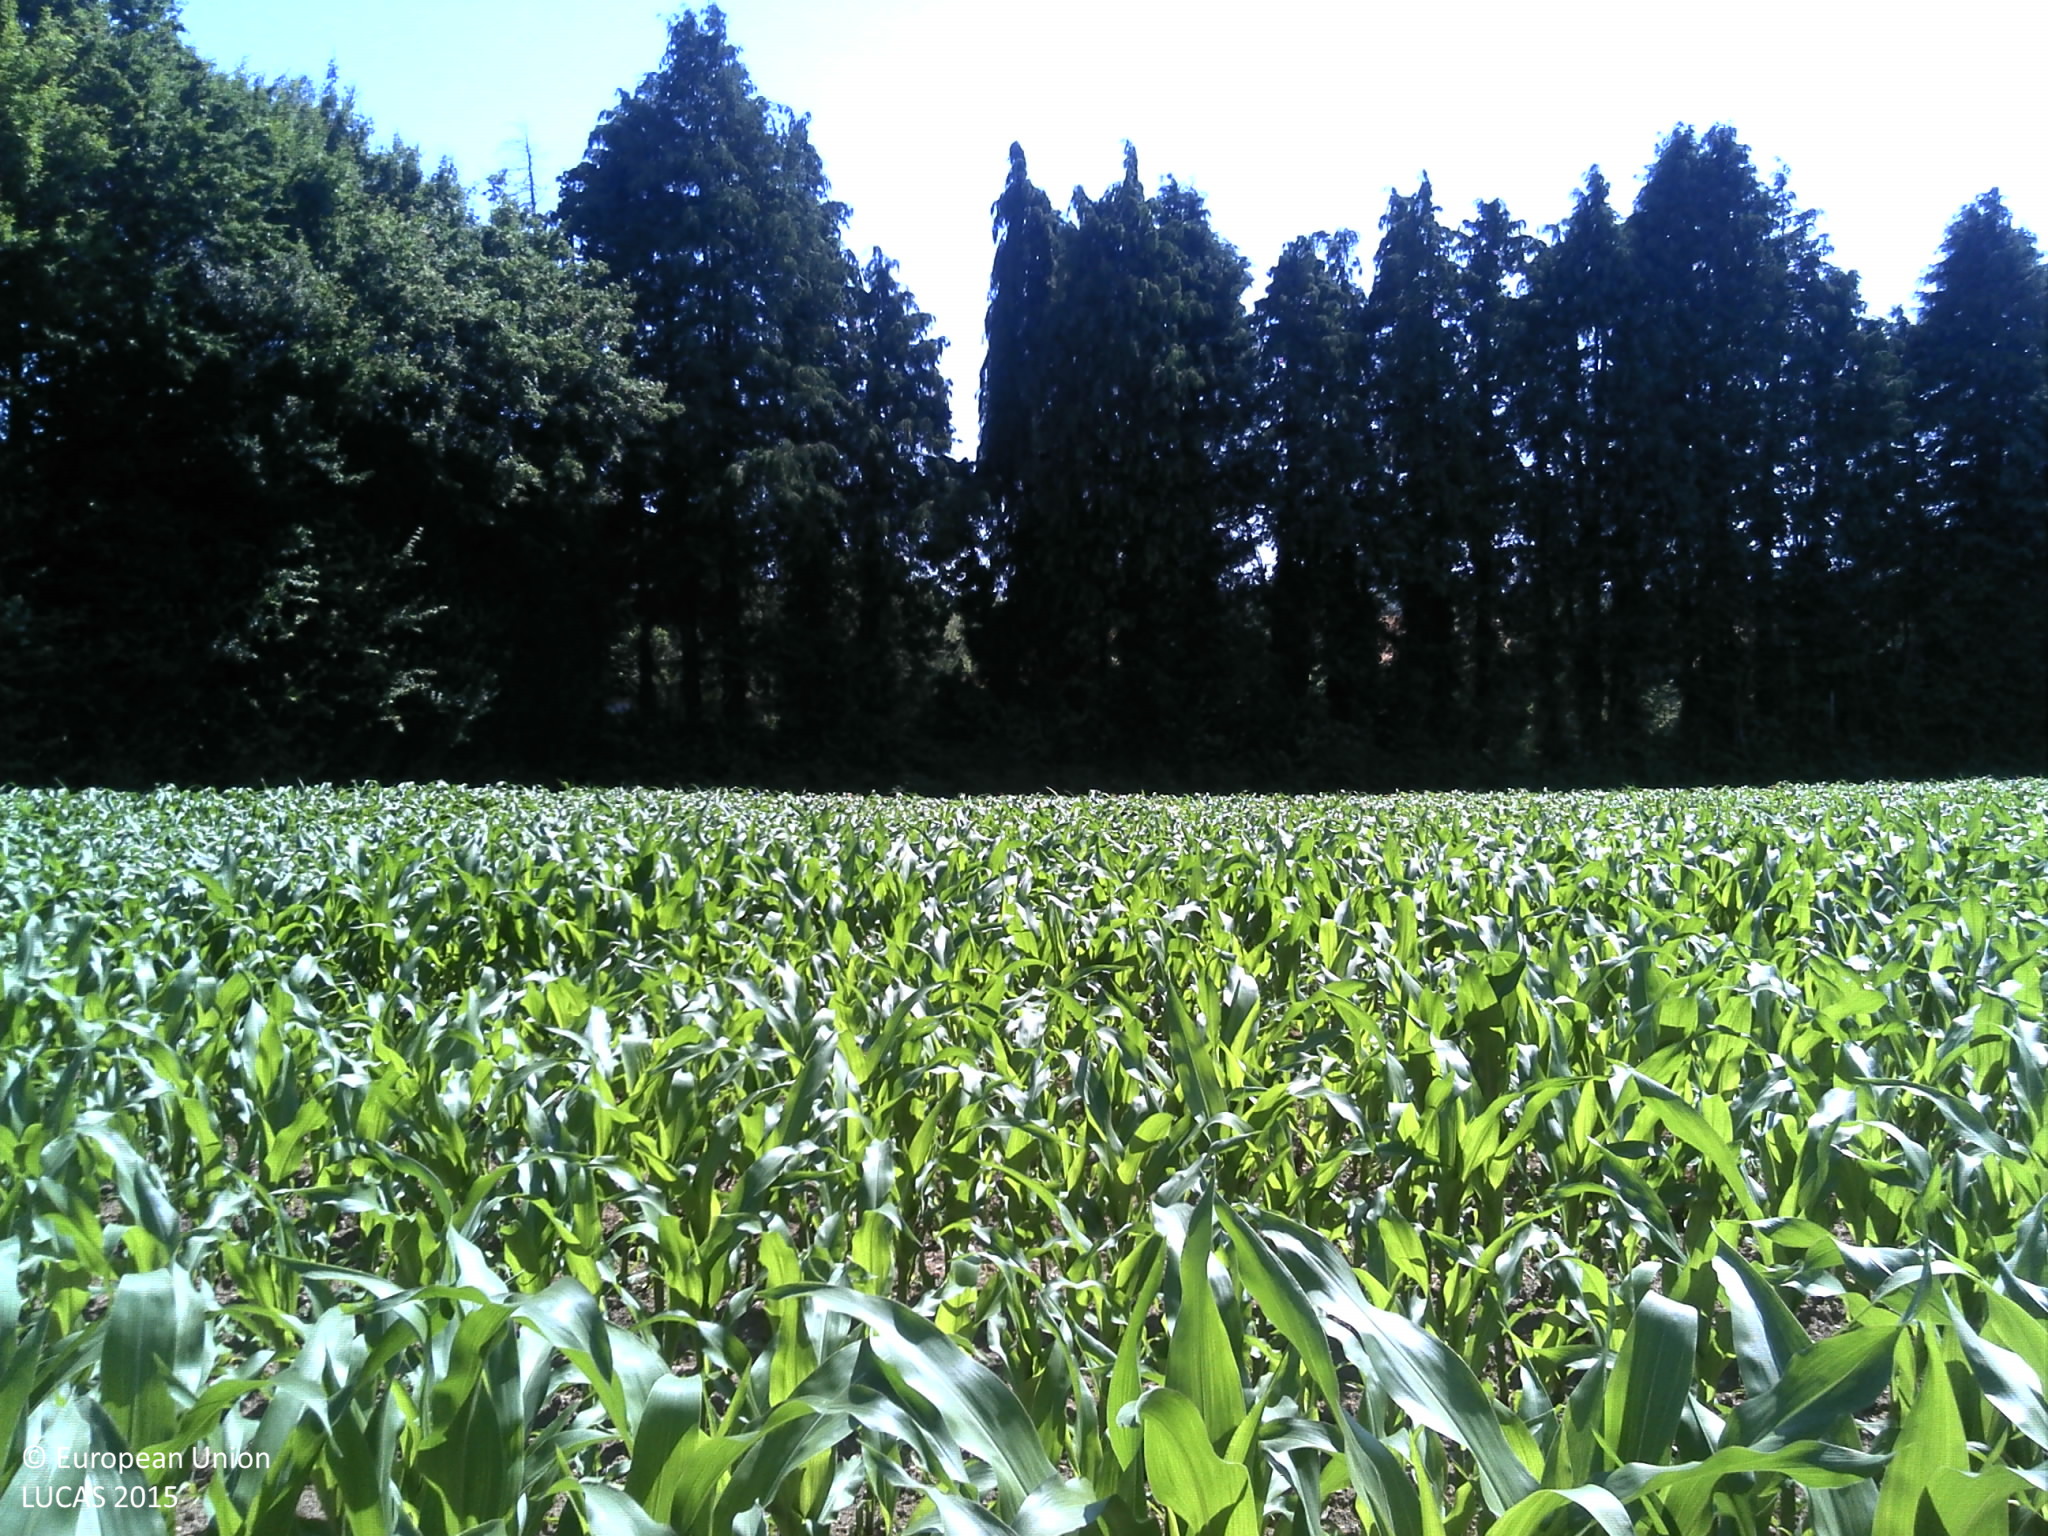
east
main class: Cropland
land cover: Maize
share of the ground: > 75 %
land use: Agriculture (excluding fallow land and kitchen gardens)
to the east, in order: Maize; Conifer hedges; Paved roads, cycling and walking lanes; Electric lines; Grassland without tree/shrub cover; Potatoes; Managed hedges; Ditches and canals; Grass margins; Paved roads, cycling and walking lanes; Grass margins; Managed hedges; Oats; Electric lines; Oats; Broadleaved woodland
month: June
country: FR
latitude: 48.2321
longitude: -3.6101
